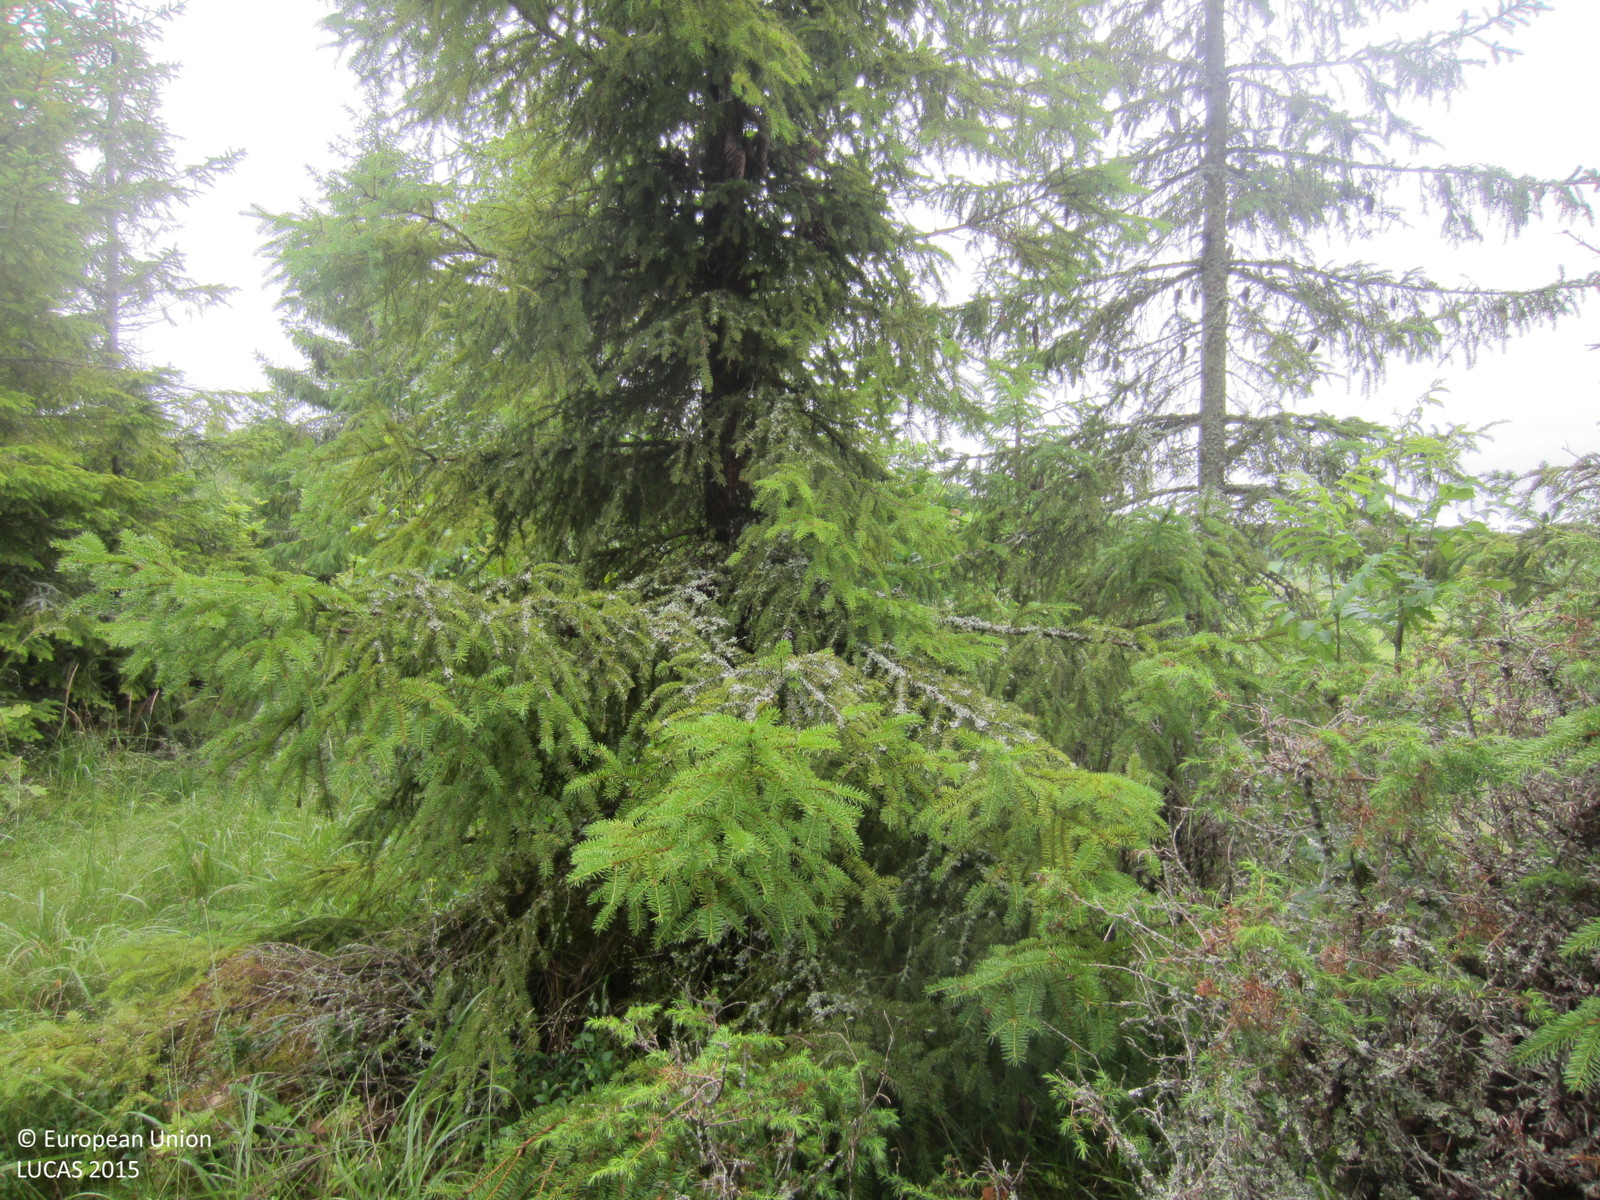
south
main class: Woodland
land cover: Spruce dominated coniferous woodland
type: boreal forest
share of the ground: 50 - 75 %
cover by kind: coniferous forest trees 55 %, herbaceous plants 20 %, lichens and mosses 20 %, broadleaved forest trees 5 %
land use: Forestry
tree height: > 5 m
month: July
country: SE
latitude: 59.8652
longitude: 16.9387
